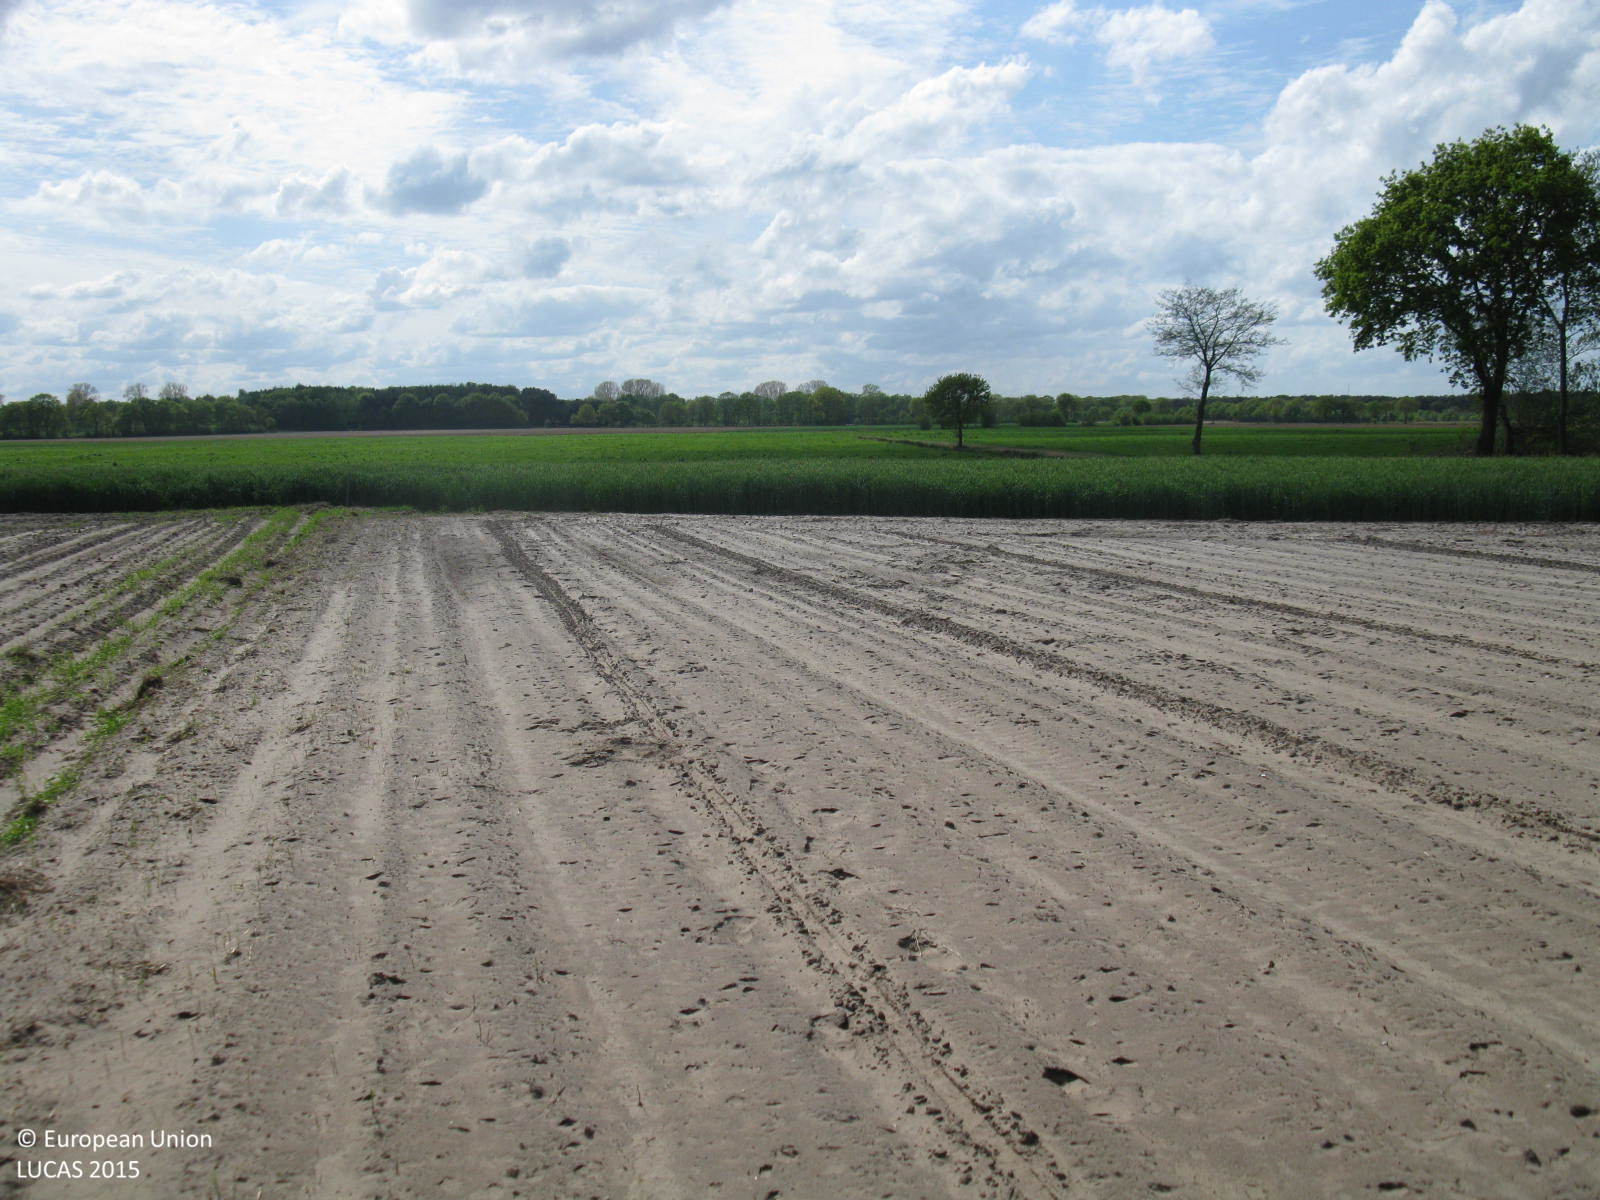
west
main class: Cropland
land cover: Other fresh vegetables
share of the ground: 25 - 50 %
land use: Agriculture (excluding fallow land and kitchen gardens)
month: May
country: DE
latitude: 52.9950
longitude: 7.3336
